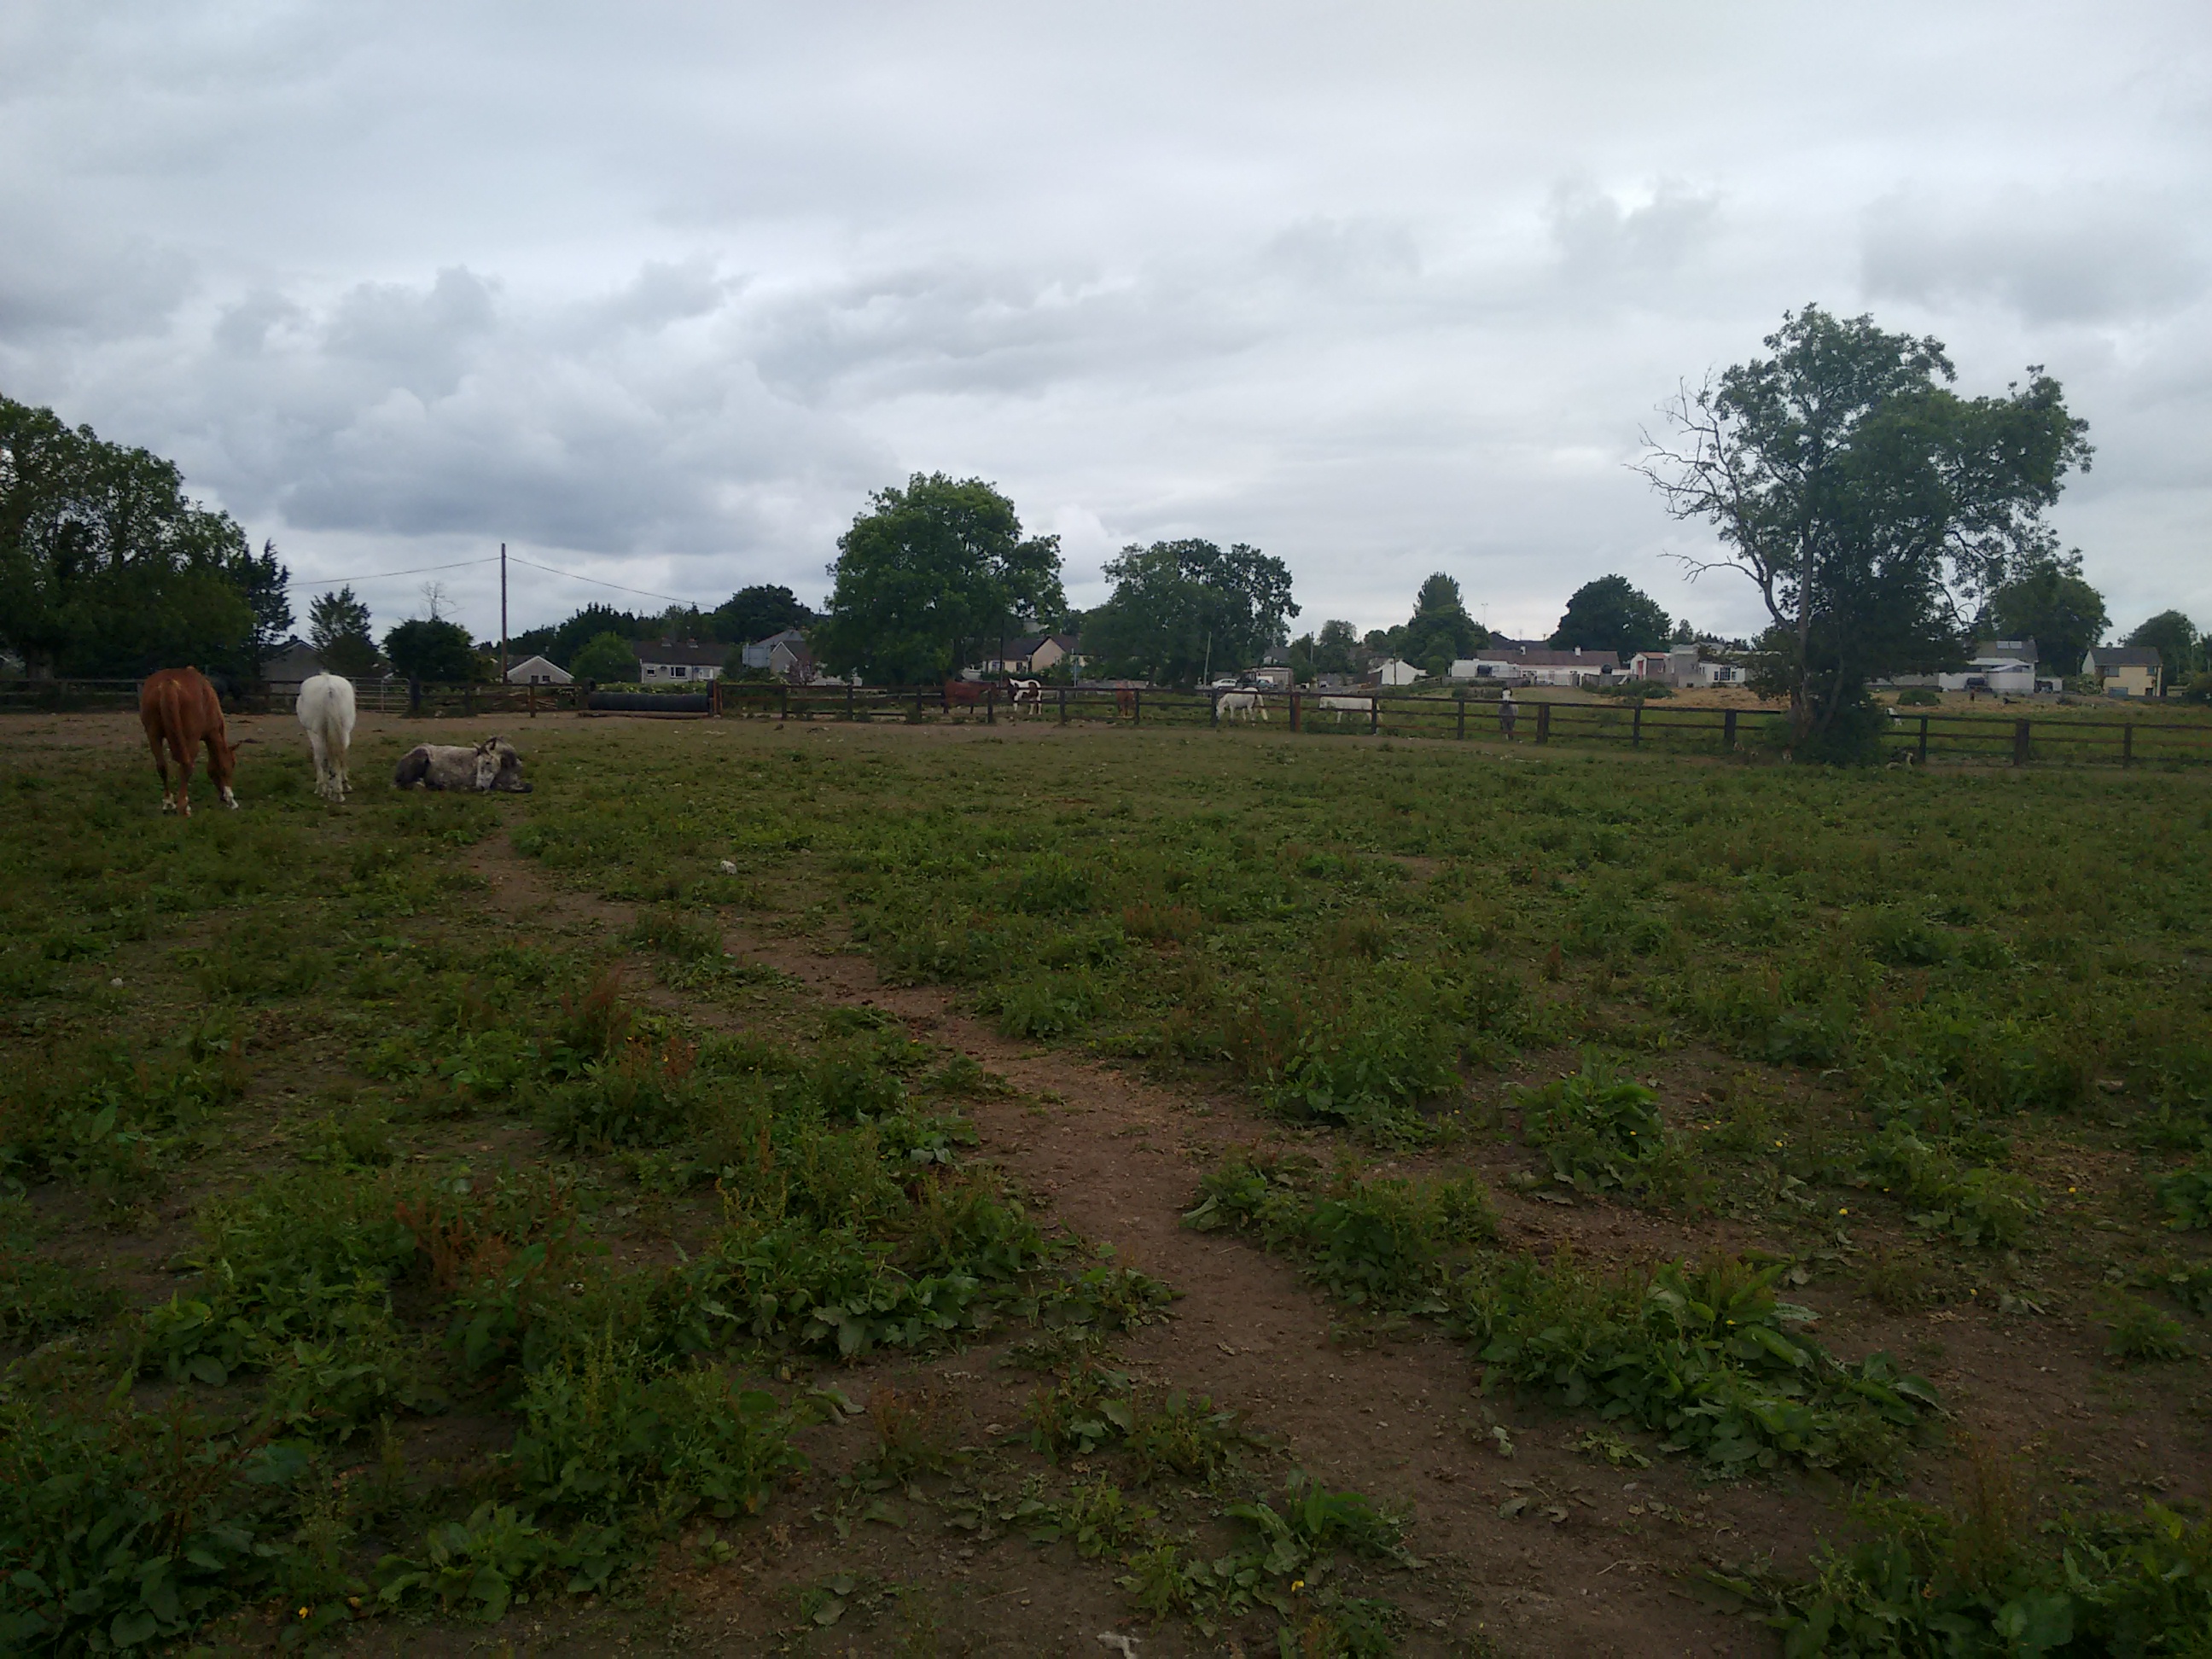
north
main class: Grassland
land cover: Spontaneously vegetated surfaces
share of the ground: > 75 %
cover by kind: herbaceous plants 50 %, consolidated bare surface 45 %, shrubs 5 %
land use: Agriculture (excluding fallow land and kitchen gardens)
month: June
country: IE
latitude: 53.4154
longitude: -7.9108
